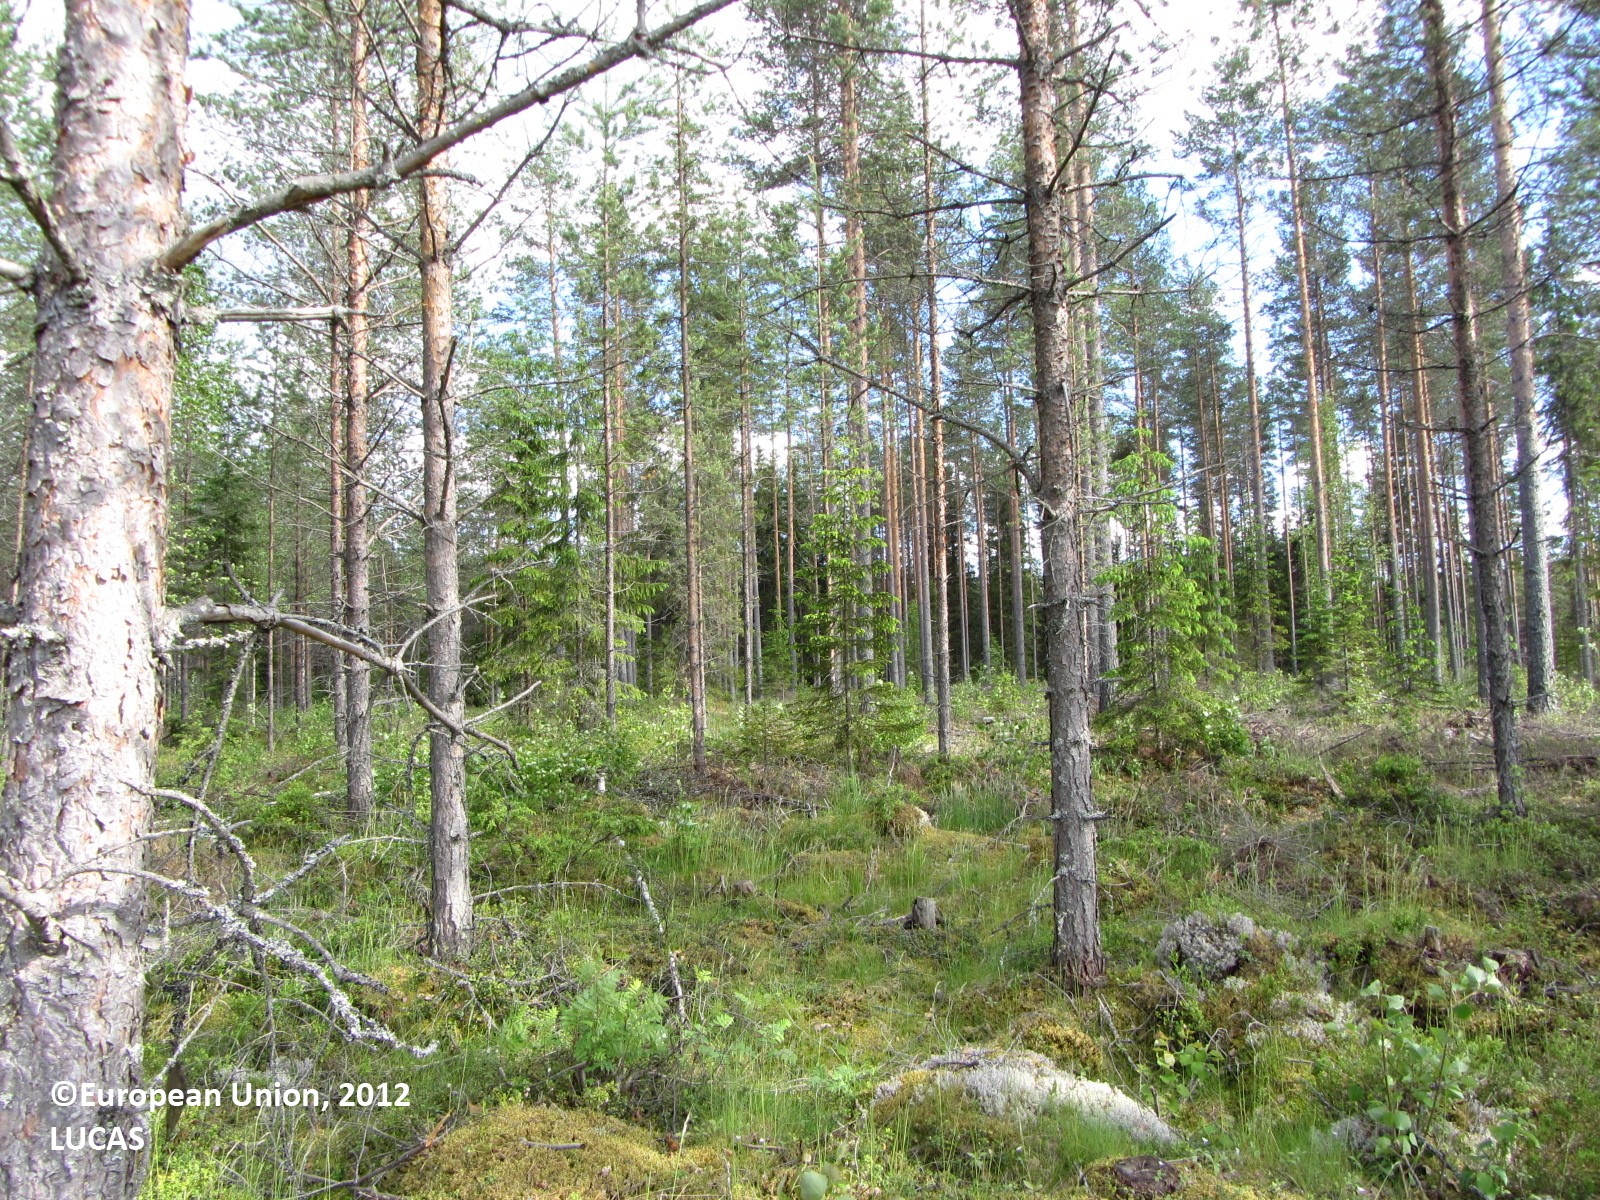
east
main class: Woodland
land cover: Pine dominated coniferous woodland
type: boreal forest
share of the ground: 50 - 75 %
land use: Forestry
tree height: > 5 m
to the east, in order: Pine dominated coniferous woodland; Tracks; Pine dominated mixed woodland; Tracks; Pine dominated mixed woodland; Tracks; Other mixed woodland; Ditches and canals; Pine dominated mixed woodland; Tracks; Pine dominated mixed woodland; Other mixed woodland; Ditches and canals; Pine dominated mixed woodland; Ditches and canals; Pine dominated mixed woodland; Tracks; Pine dominated mixed woodland; Shrubland without tree cover; Ditches and canals
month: June
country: FI
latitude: 62.3410
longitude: 25.1080
